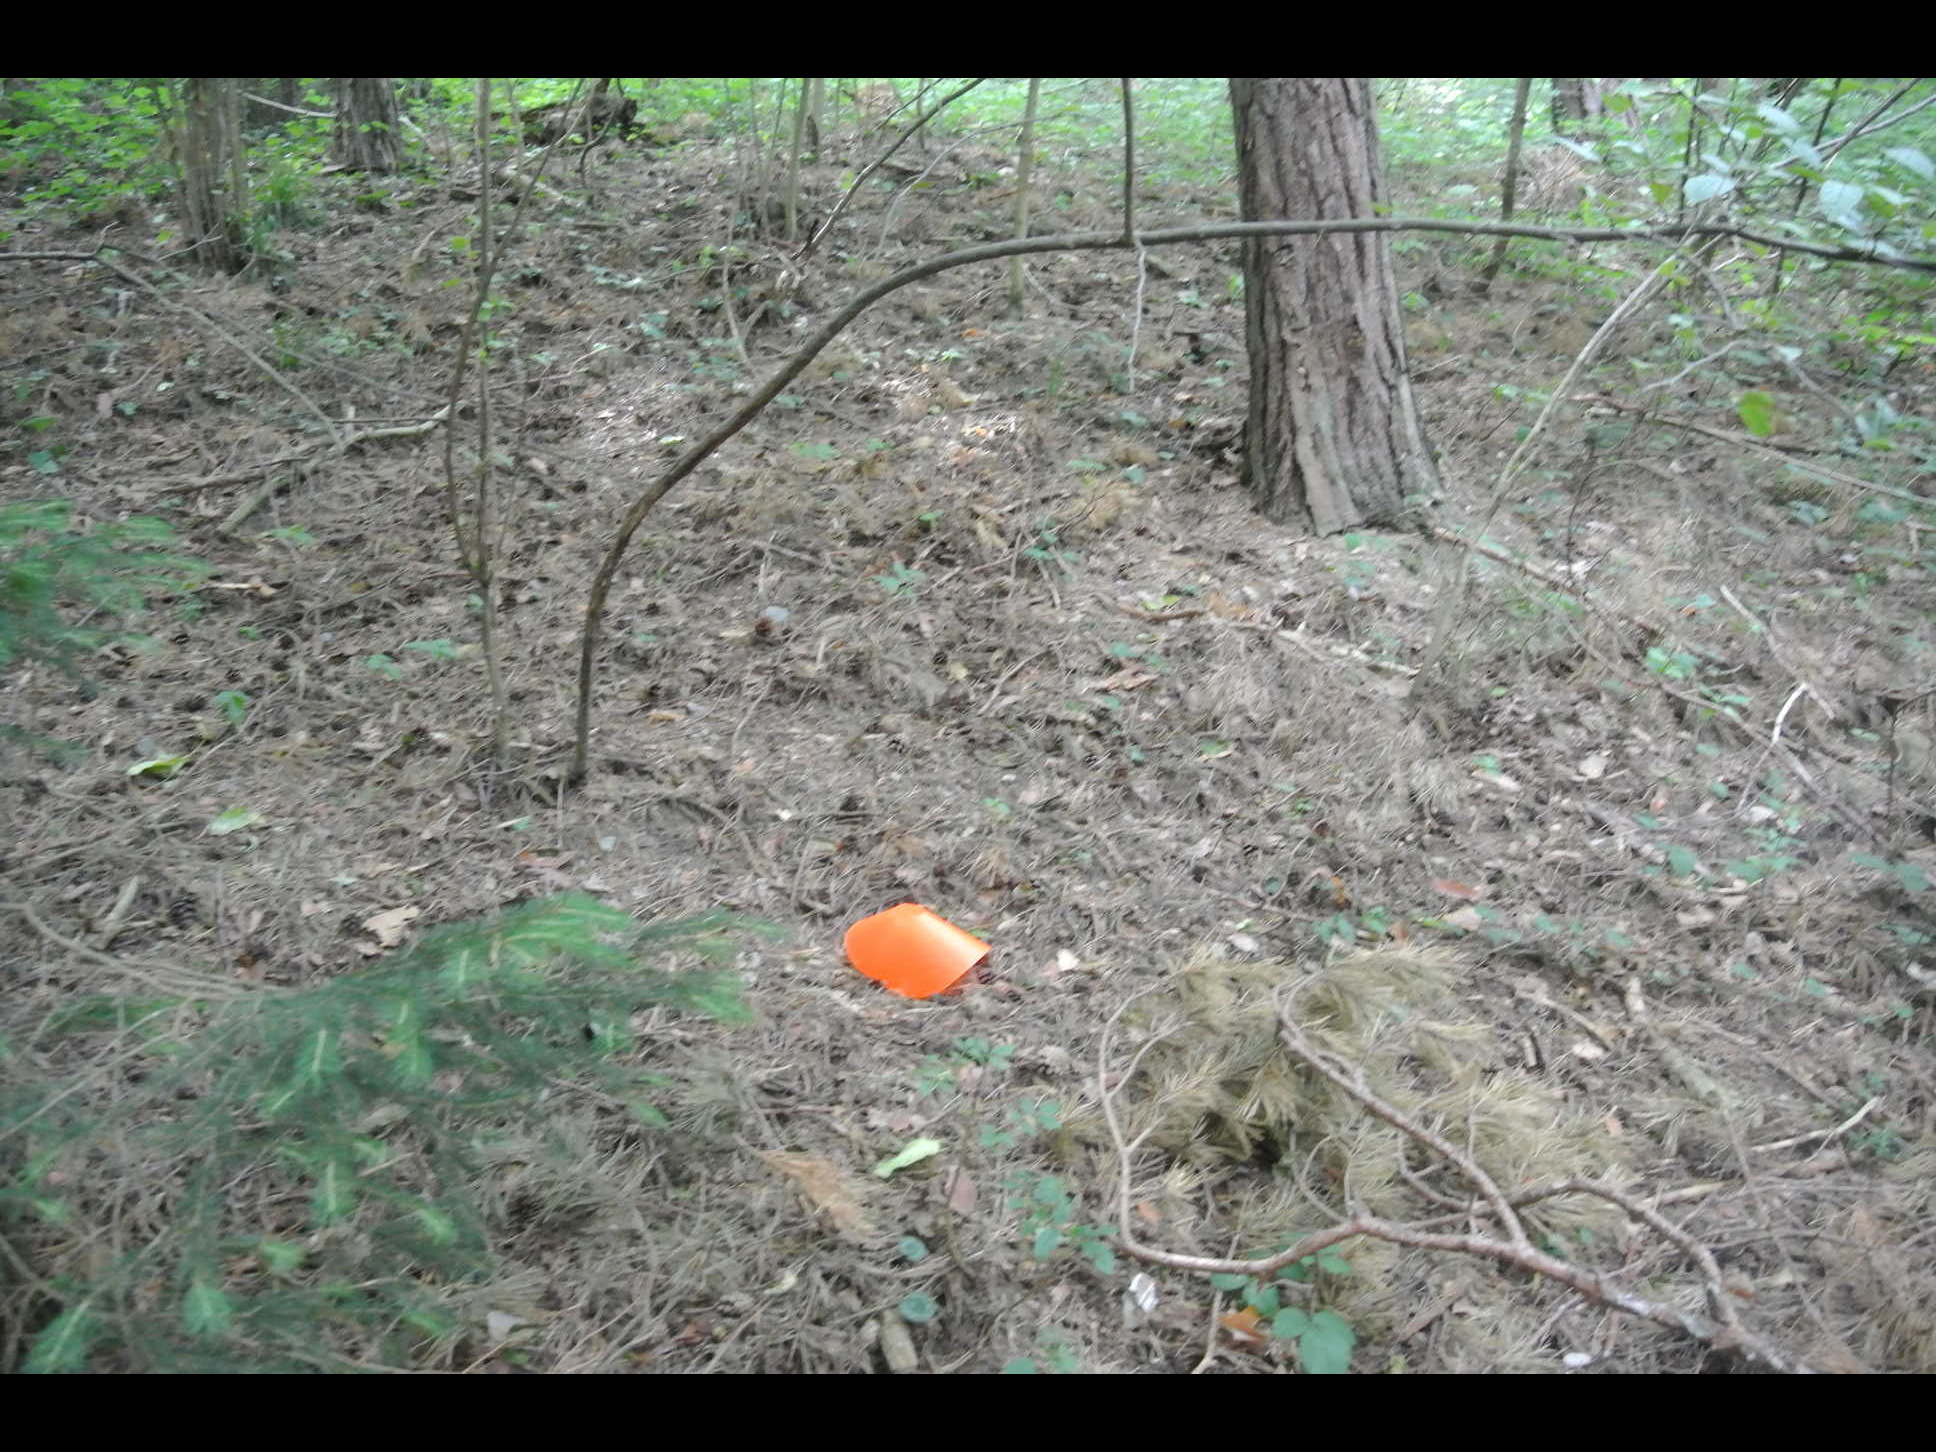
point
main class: Woodland
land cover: Other mixed woodland
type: alpine coniferous forest
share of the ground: > 75 %
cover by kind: coniferous forest trees 70 %, broadleaved forest trees 30 %
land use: Forestry
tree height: > 5 m
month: July
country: AT
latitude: 47.7165
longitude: 16.0145
